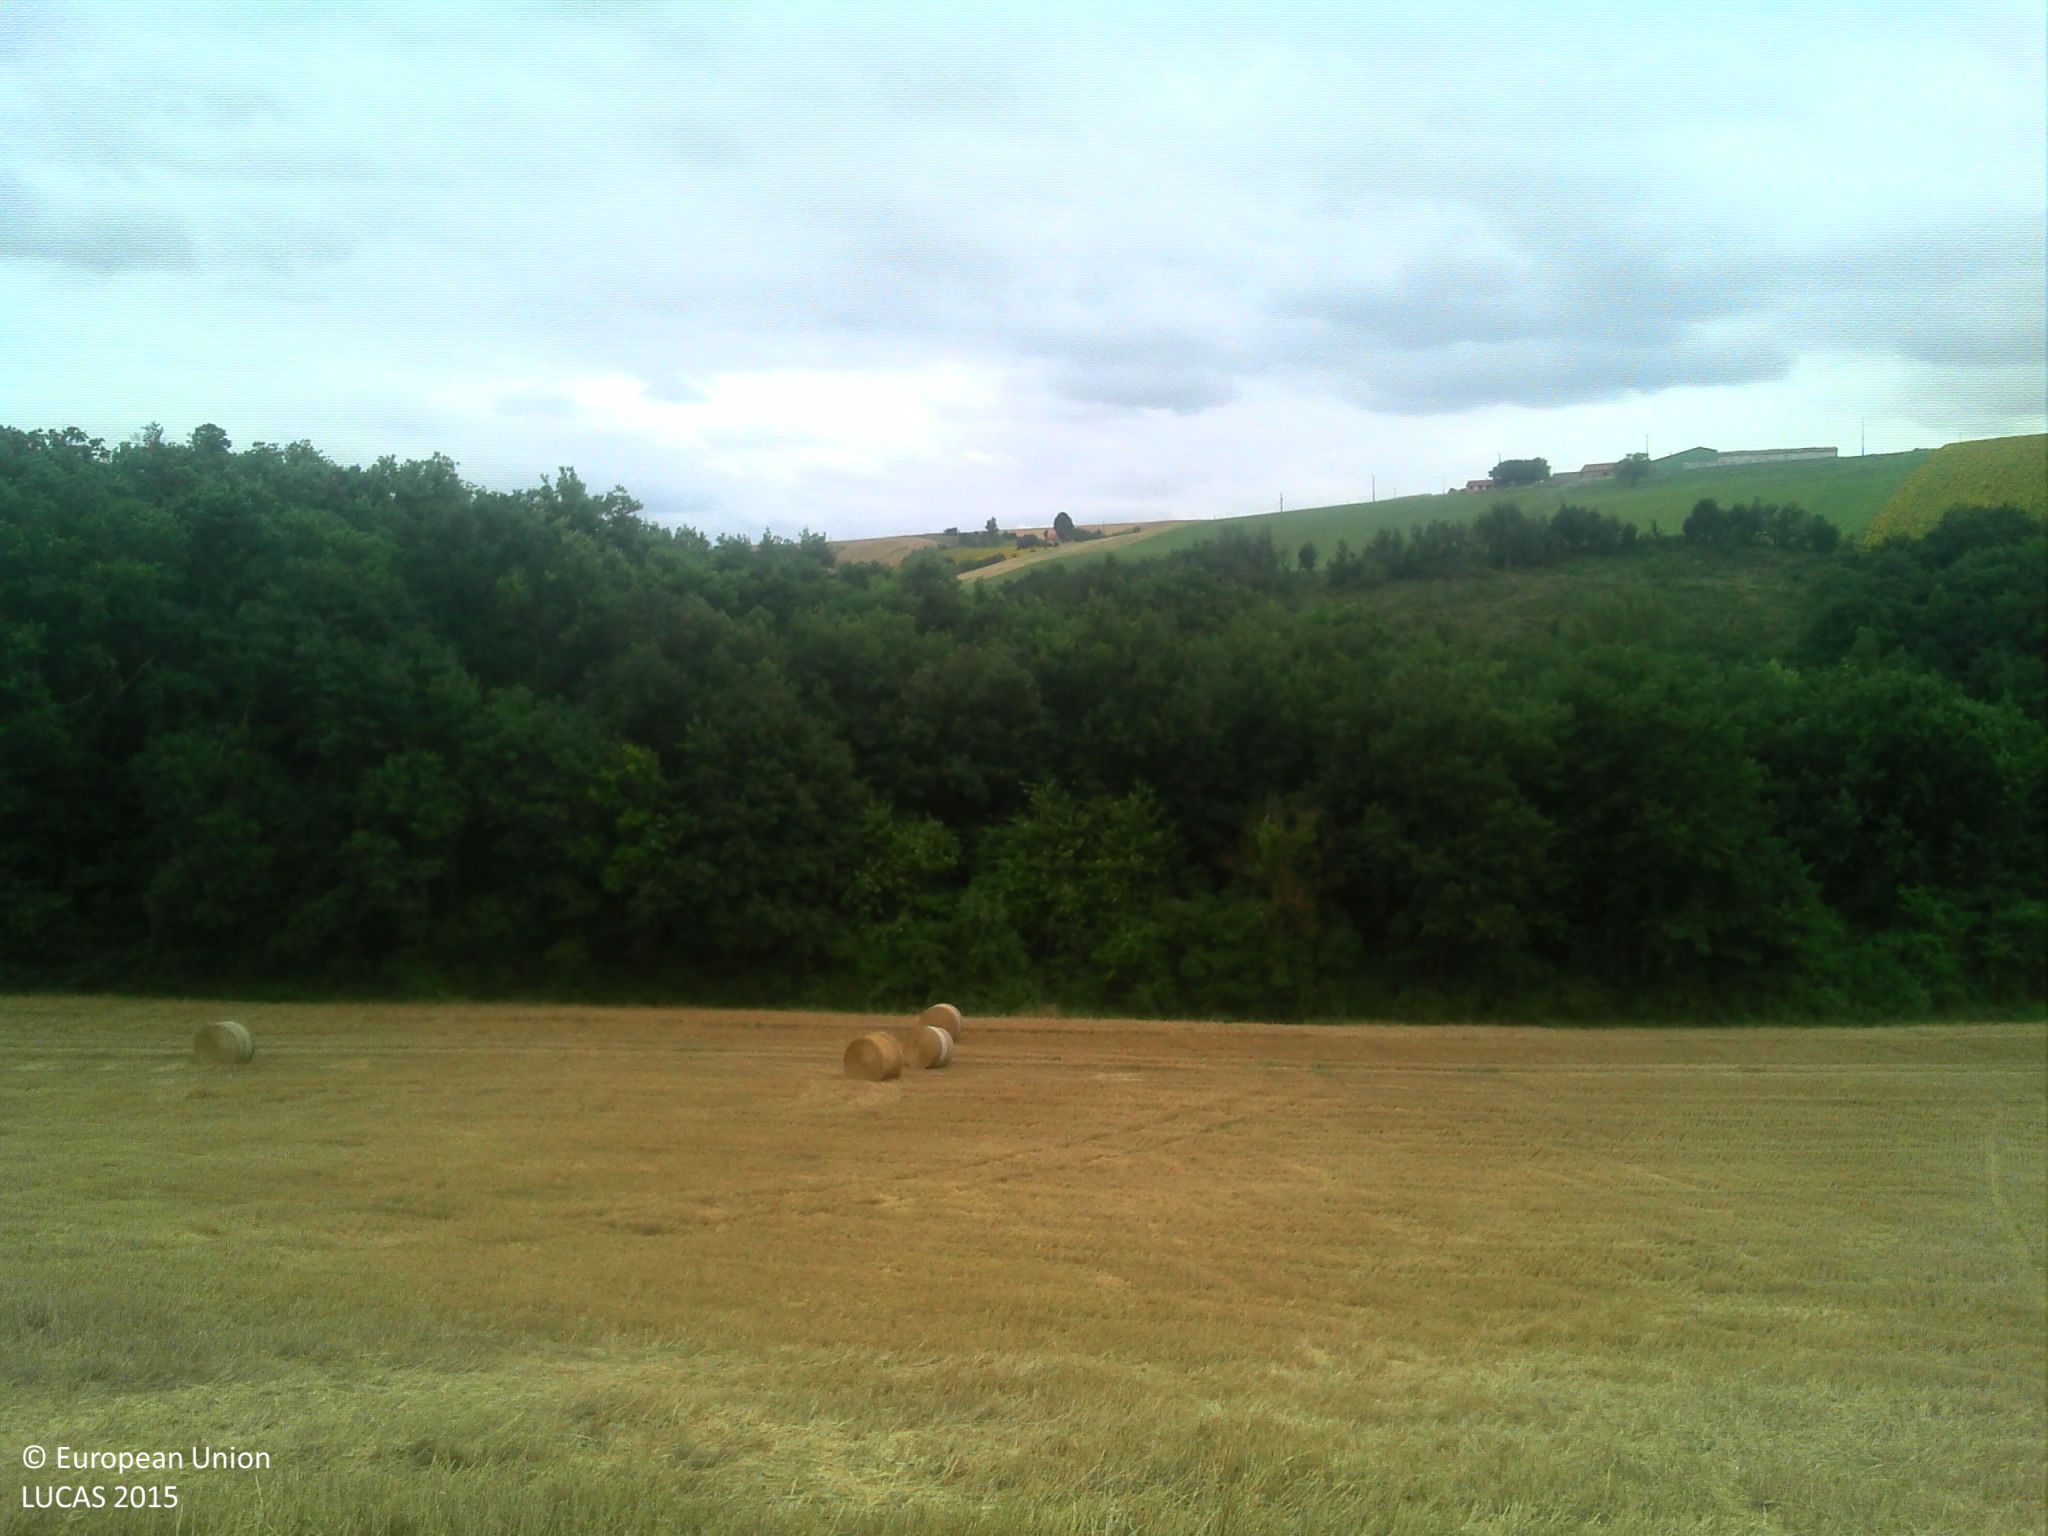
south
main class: Cropland
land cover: Common wheat
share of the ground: > 75 %
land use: Agriculture (excluding fallow land and kitchen gardens)
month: July
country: FR
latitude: 43.2849
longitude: 1.3898
